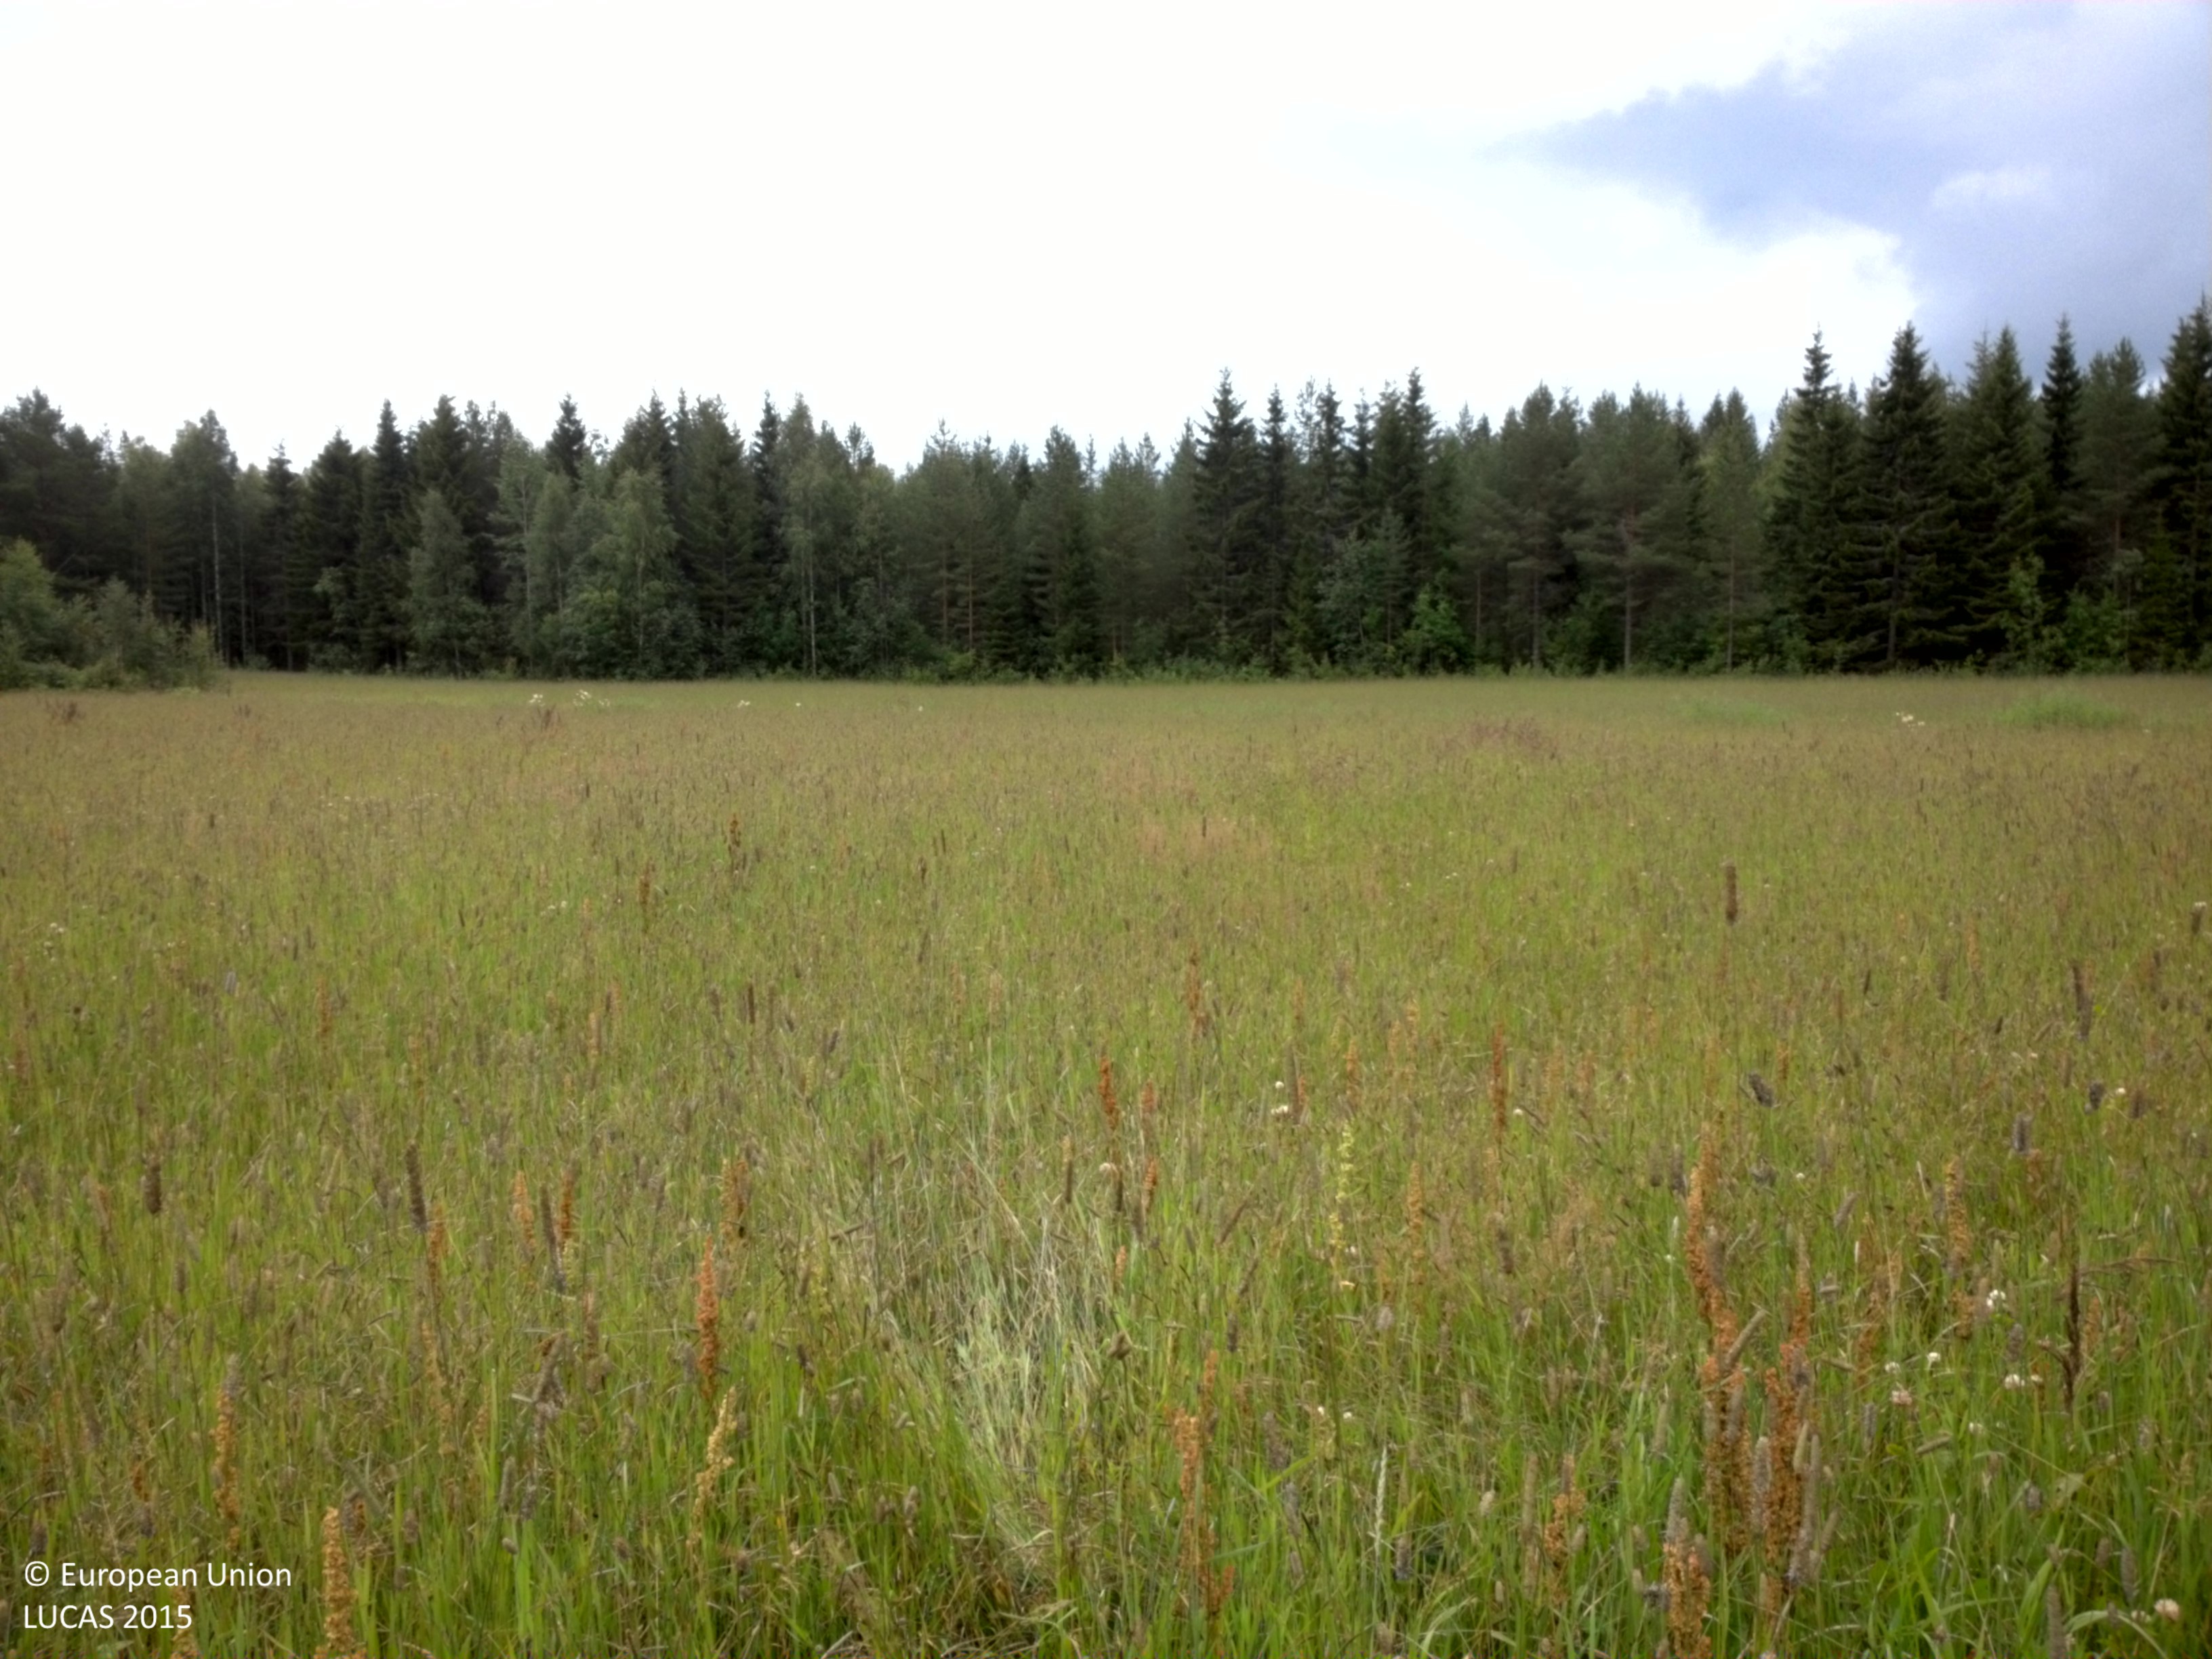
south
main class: Grassland
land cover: Grassland without tree/shrub cover
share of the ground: > 75 %
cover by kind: herbaceous plants 100 %
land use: Agriculture (excluding fallow land and kitchen gardens)
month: August
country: SE
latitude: 64.7275
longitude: 20.9999
